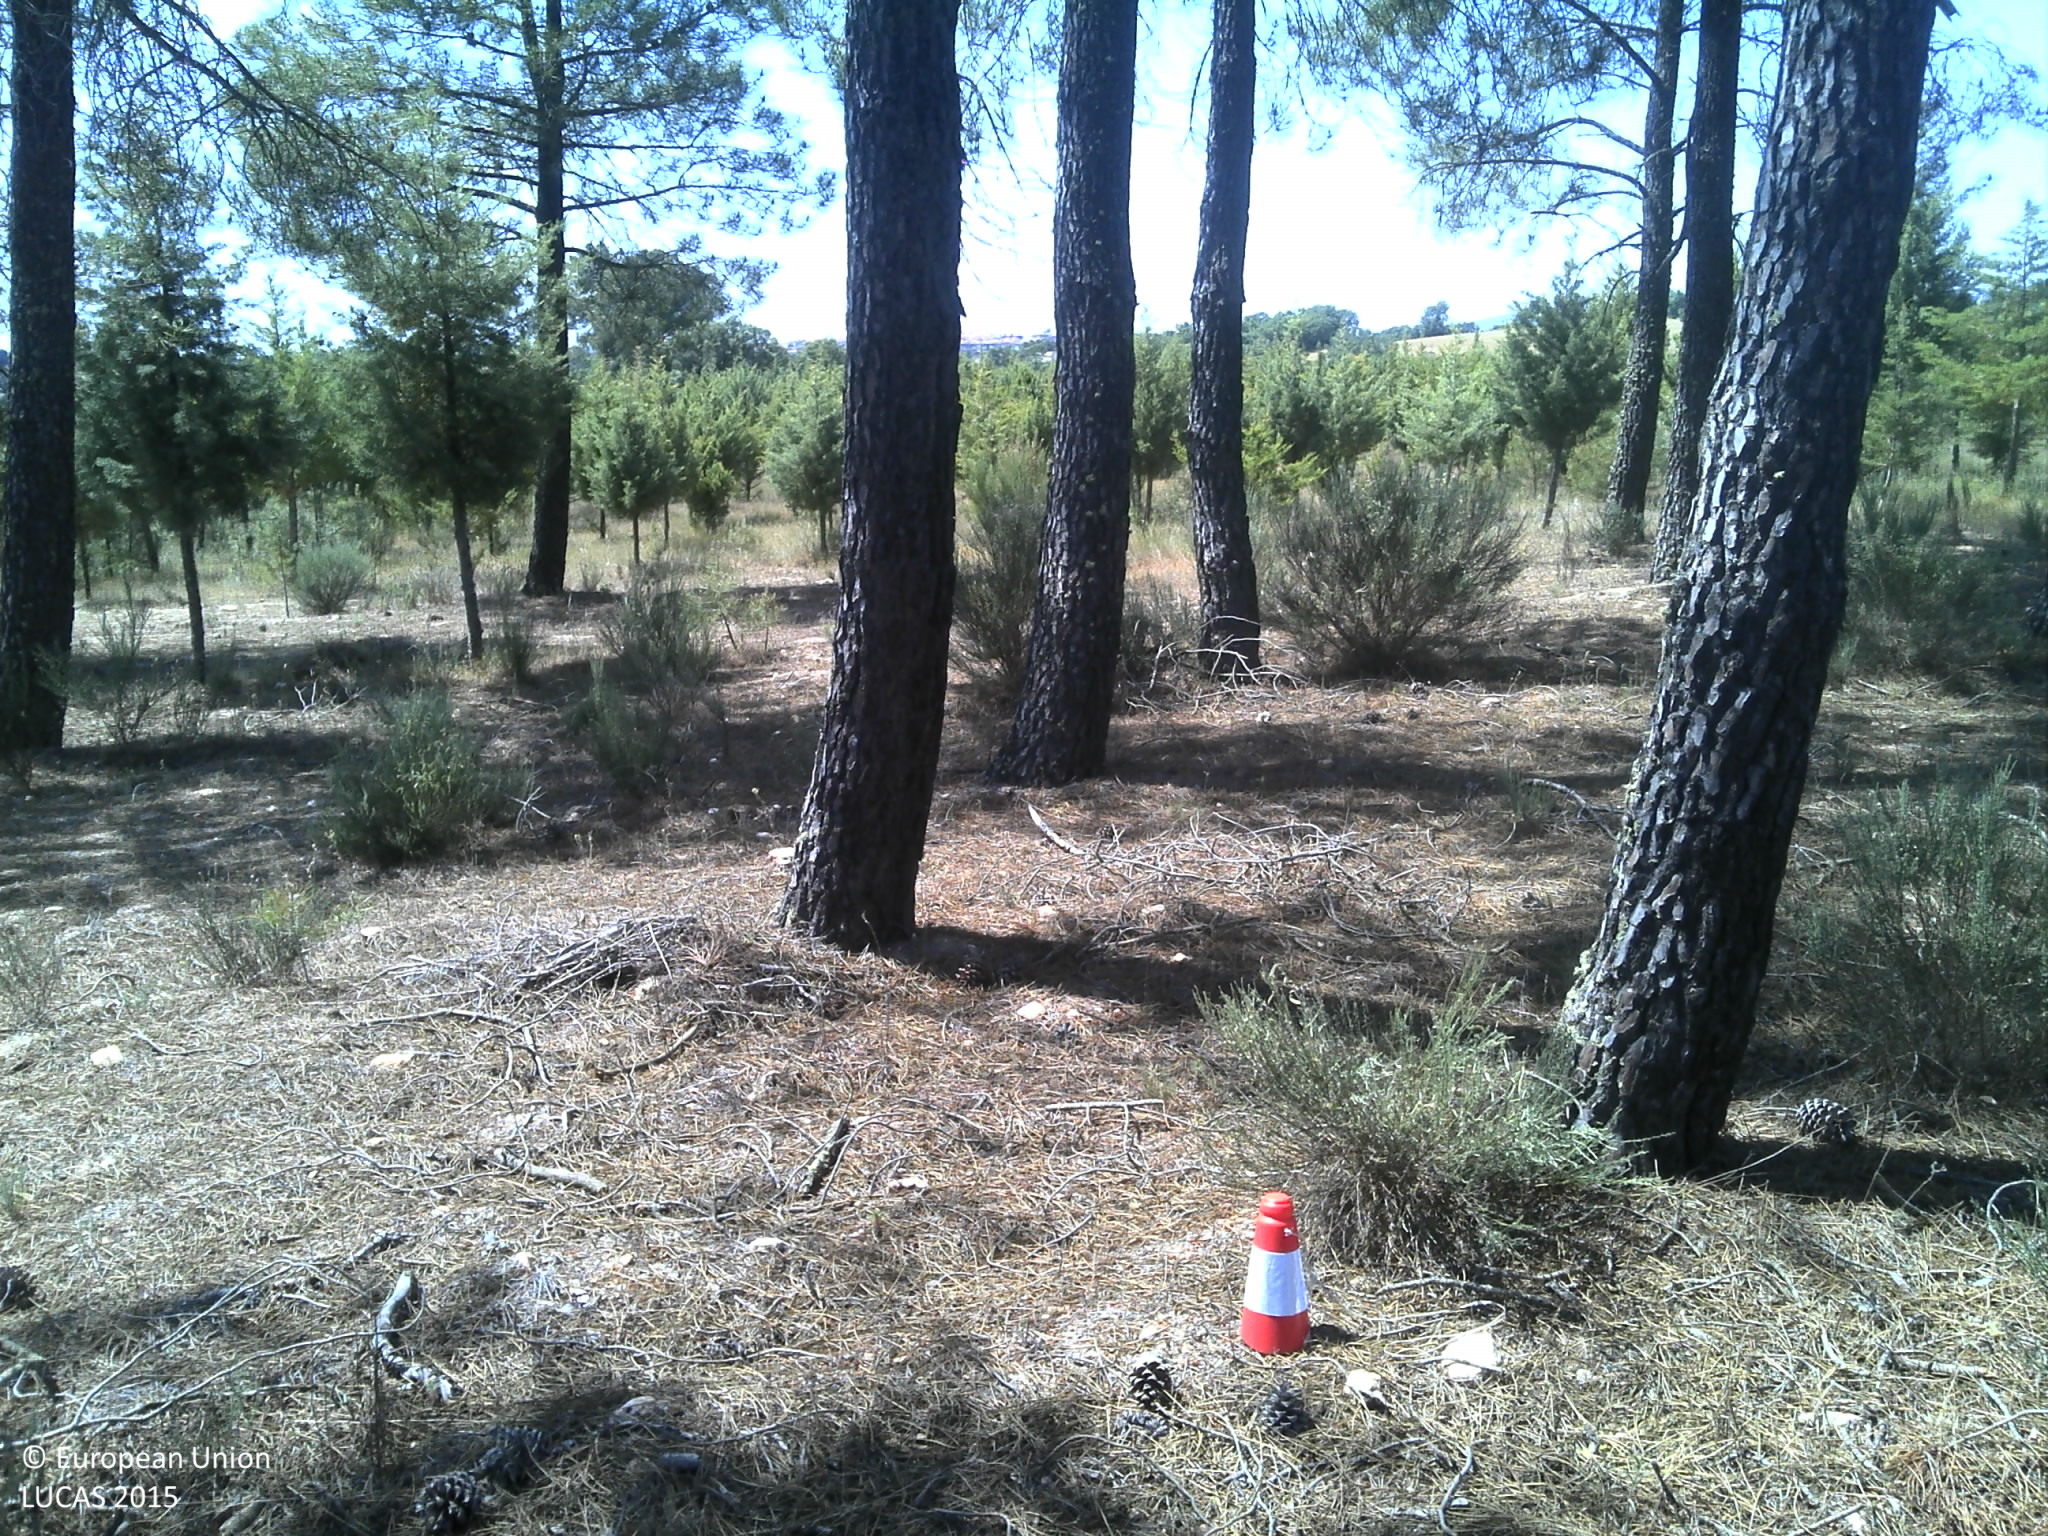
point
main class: Woodland
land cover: Pine dominated coniferous woodland
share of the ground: 50 - 75 %
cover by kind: coniferous forest trees 70 %, unconsolidated bare surface 20 %, shrubs 5 %, herbaceous plants 5 %
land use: Forestry
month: June
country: PT
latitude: 40.7109
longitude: -6.8722
